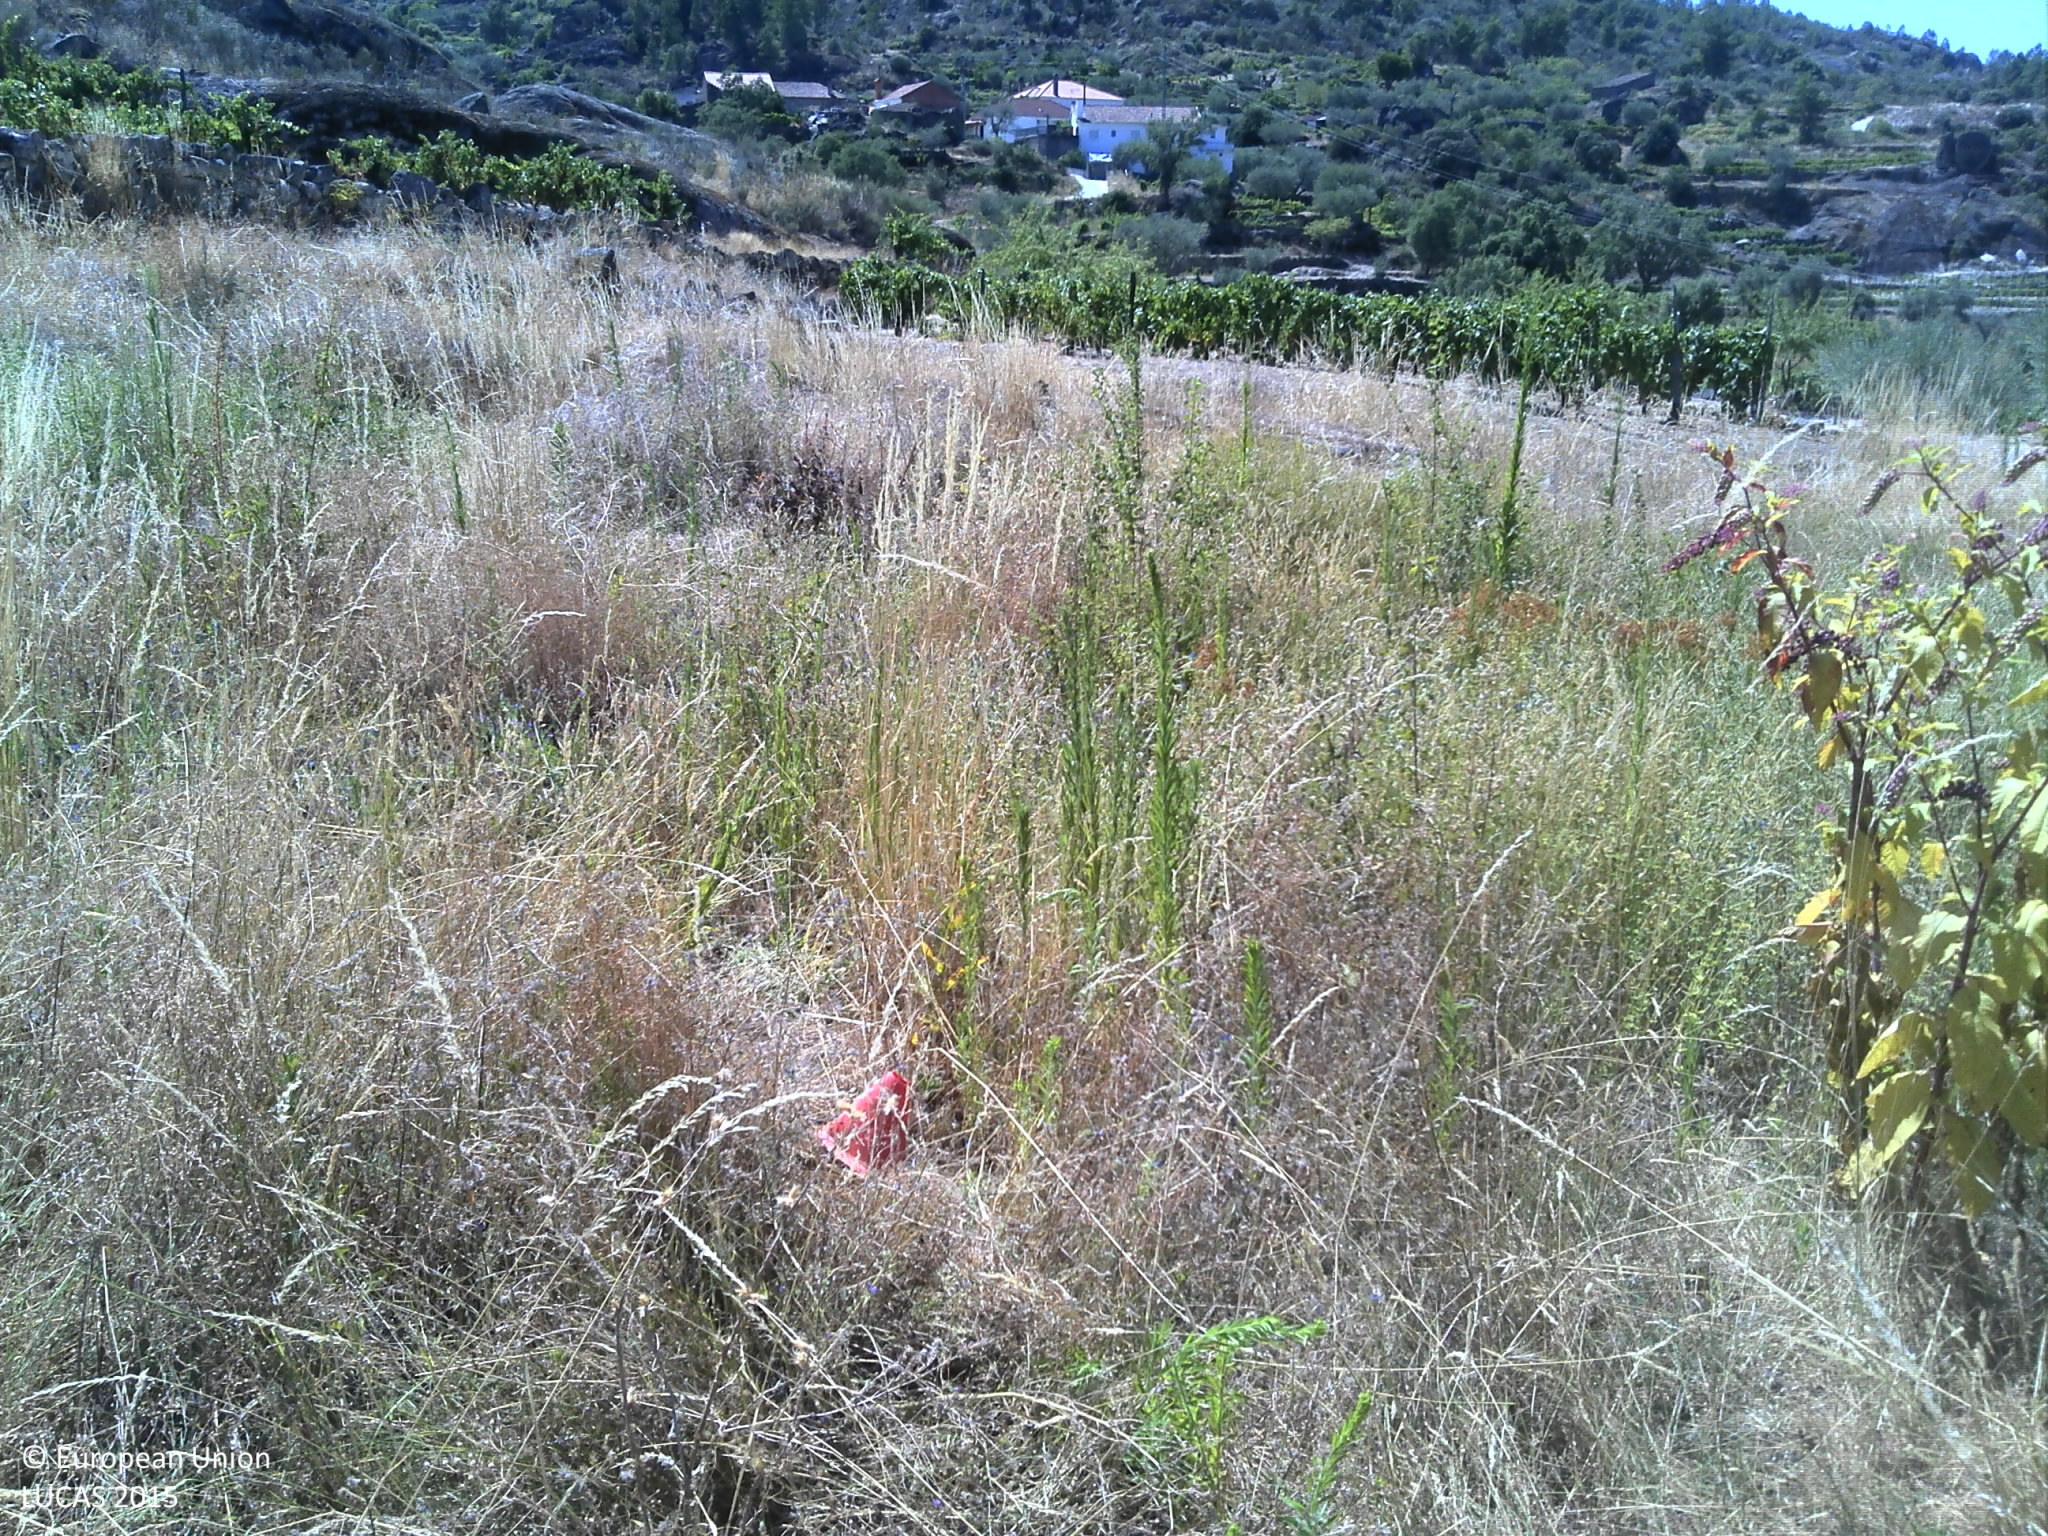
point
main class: Grassland
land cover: Grassland without tree/shrub cover
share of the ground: > 75 %
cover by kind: herbaceous plants 100 %
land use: Agriculture (excluding fallow land and kitchen gardens)
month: July
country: PT
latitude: 41.3121
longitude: -7.3327
